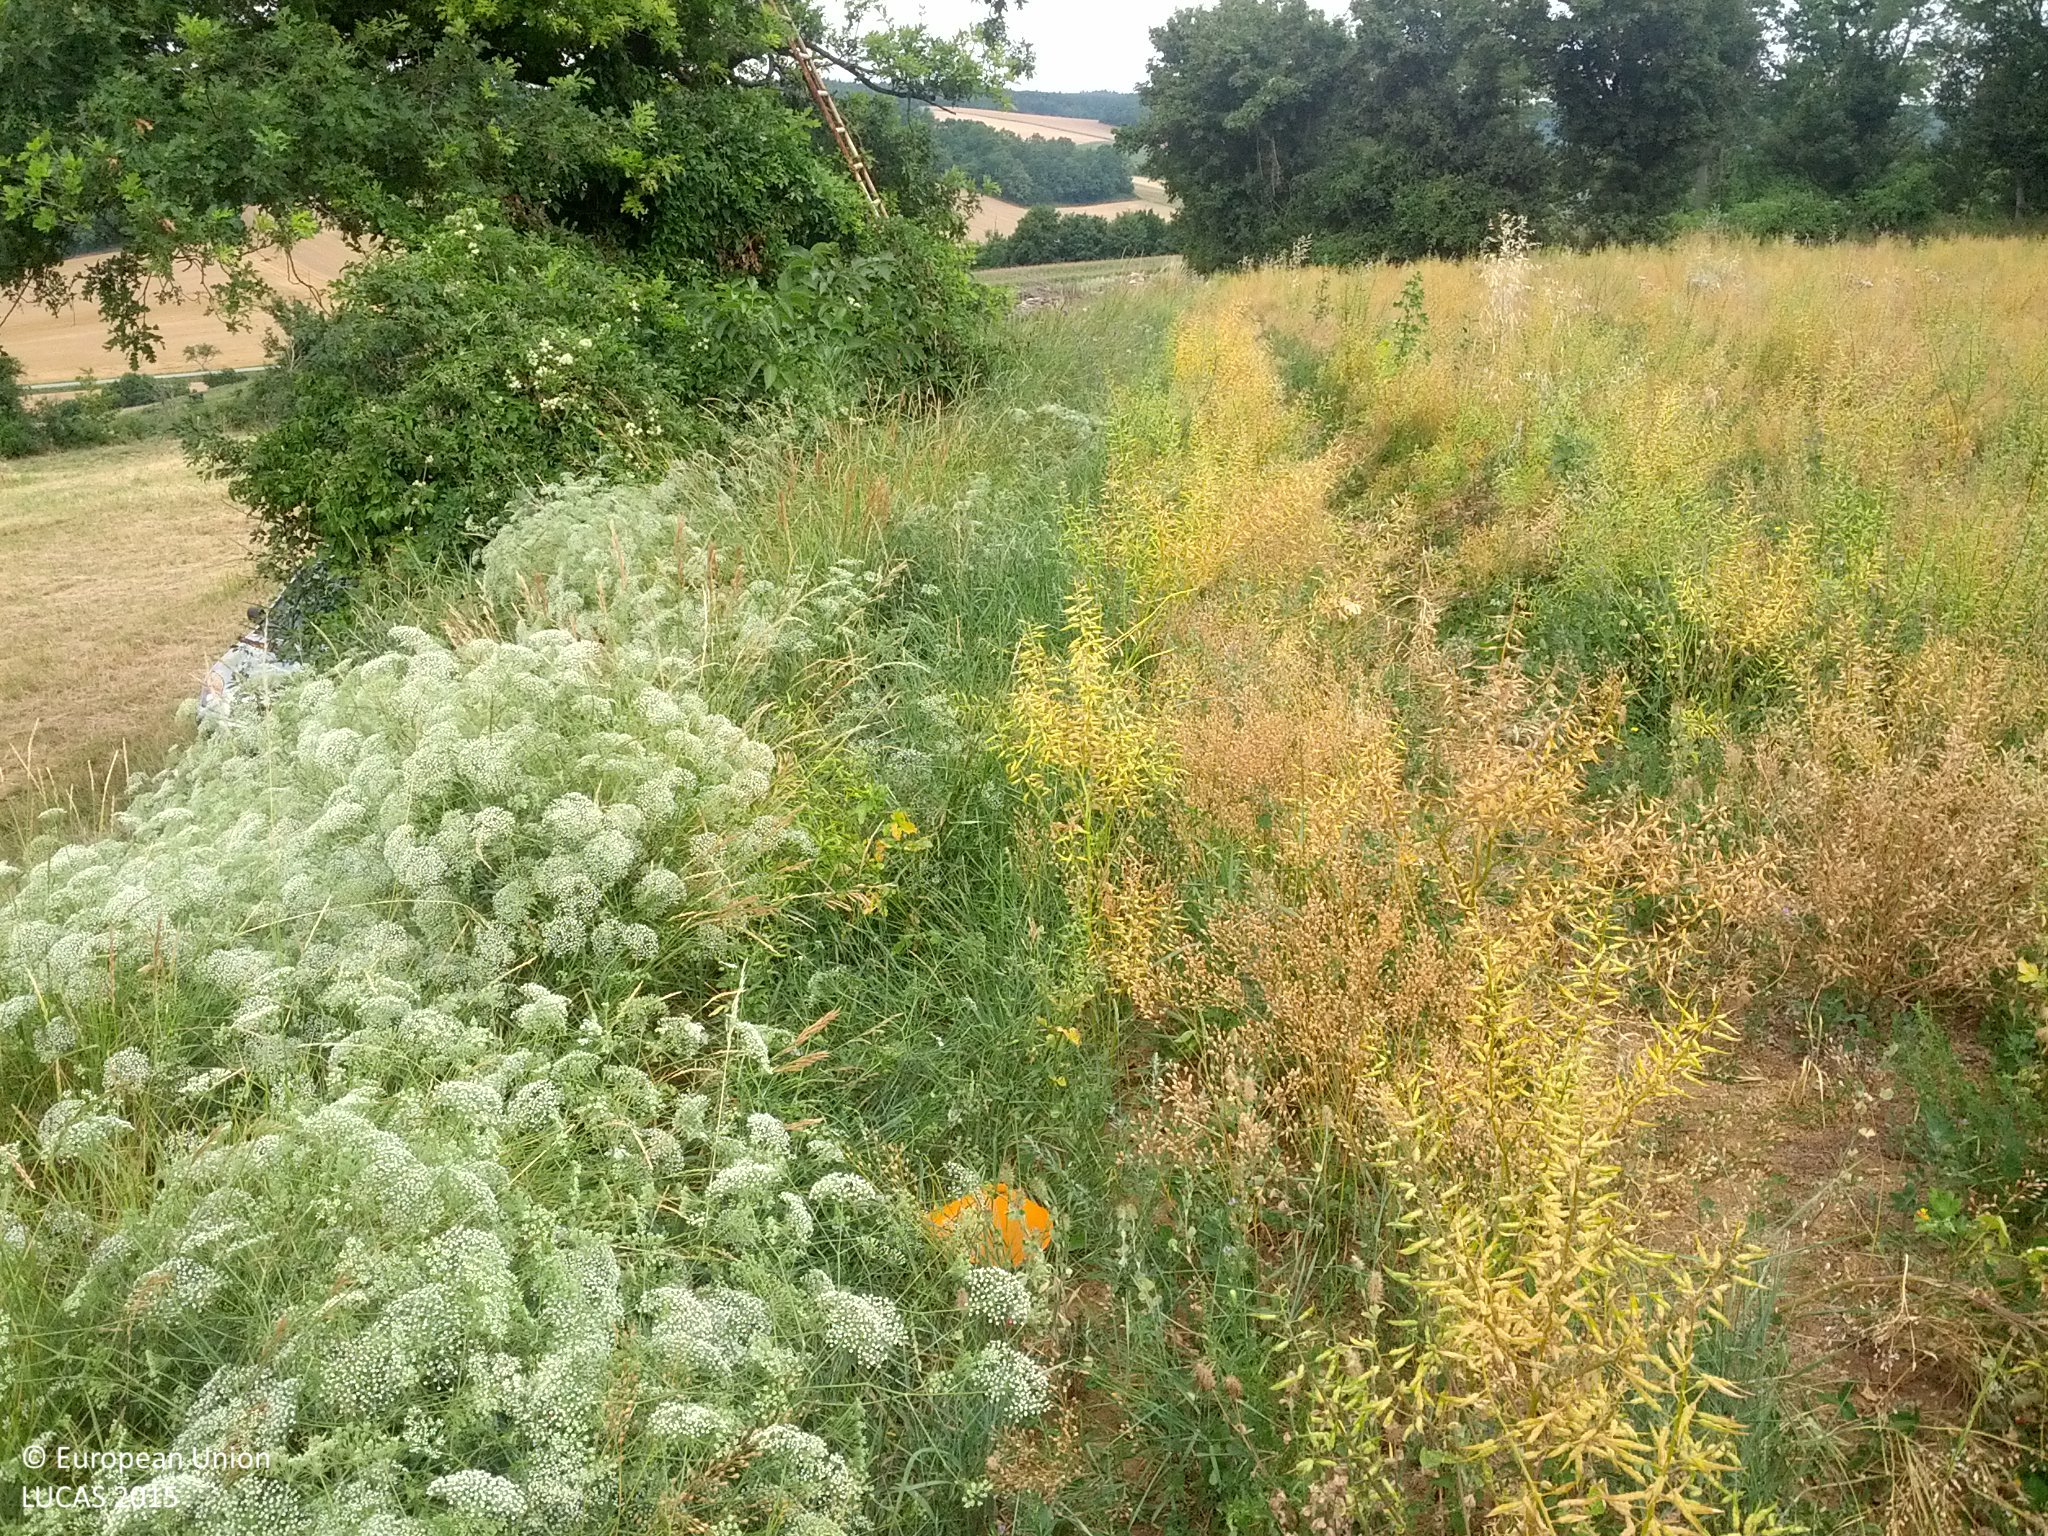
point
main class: Cropland
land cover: Other fibre and oleaginous crops
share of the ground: > 75 %
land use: Agriculture (excluding fallow land and kitchen gardens)
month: July
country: AT
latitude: 48.5202
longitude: 16.1651
